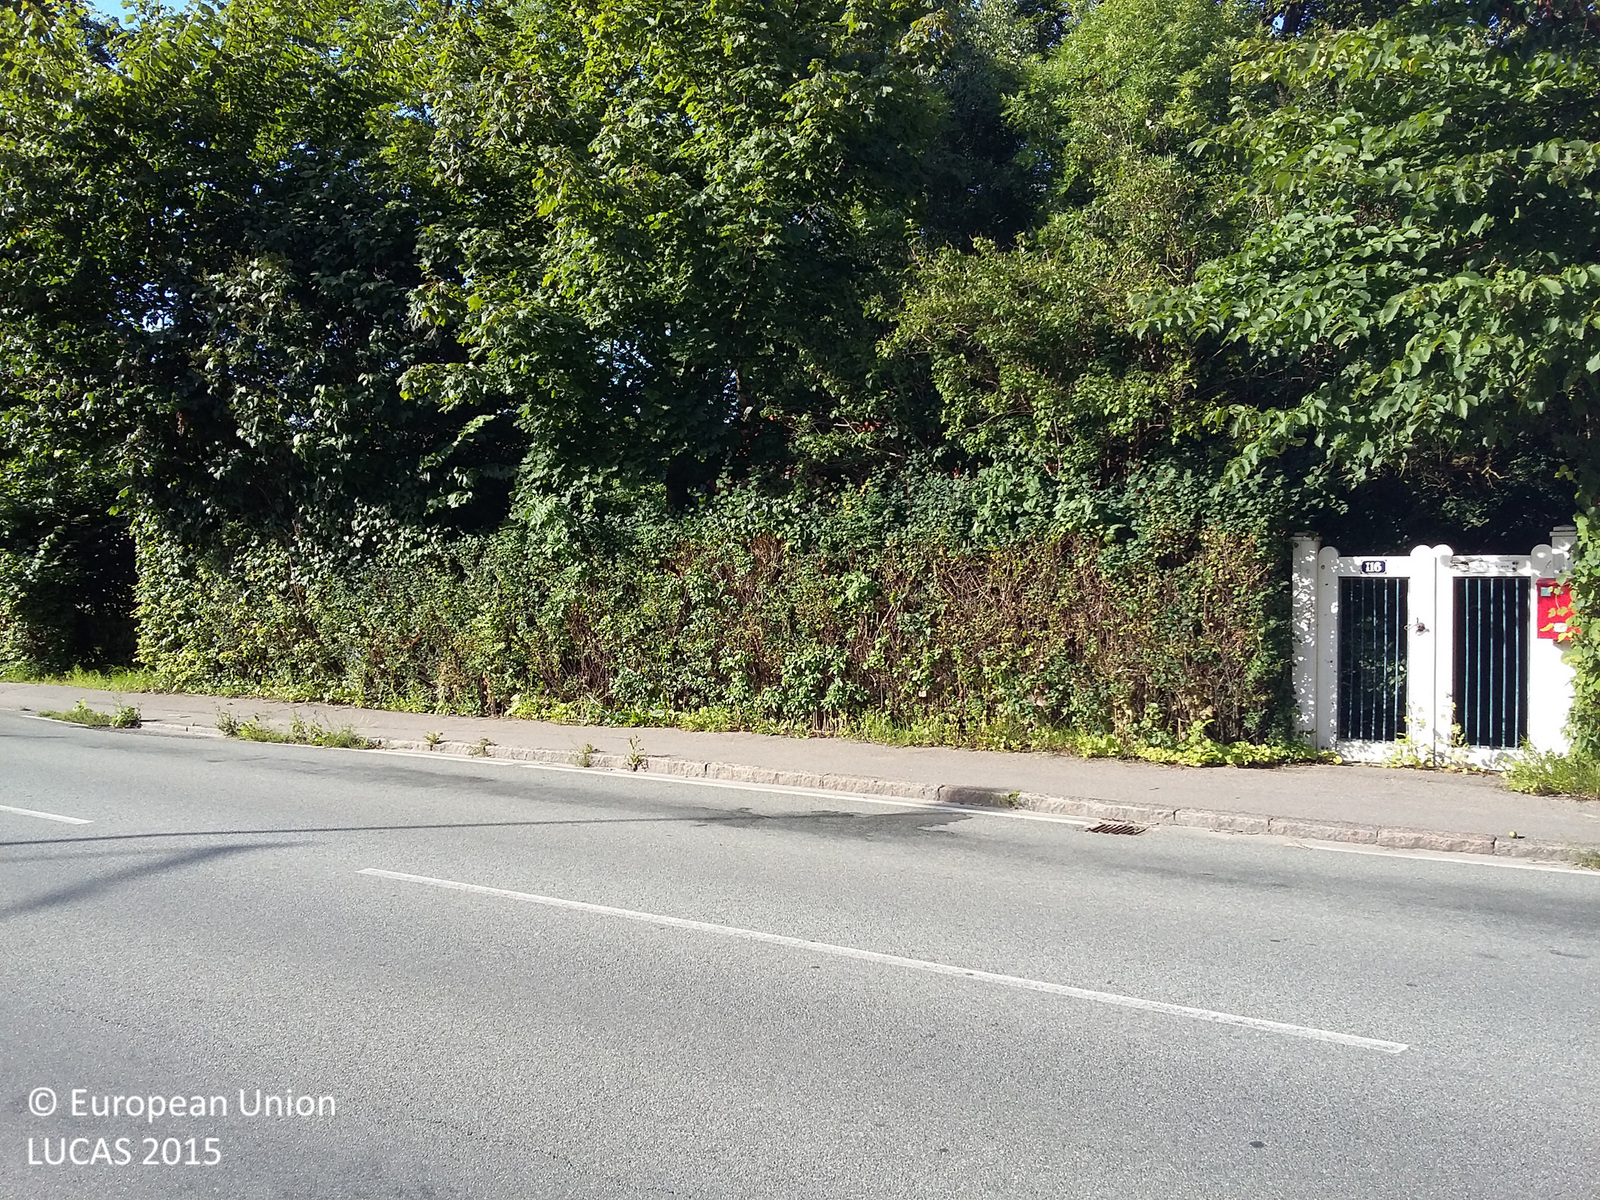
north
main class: Grassland
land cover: Grassland with sparse tree/shrub cover
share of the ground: > 75 %
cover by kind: herbaceous plants 85 %, shrubs 10 %, broadleaved forest trees 5 %
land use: Residential
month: July
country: DK
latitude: 56.0725
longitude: 12.5520
